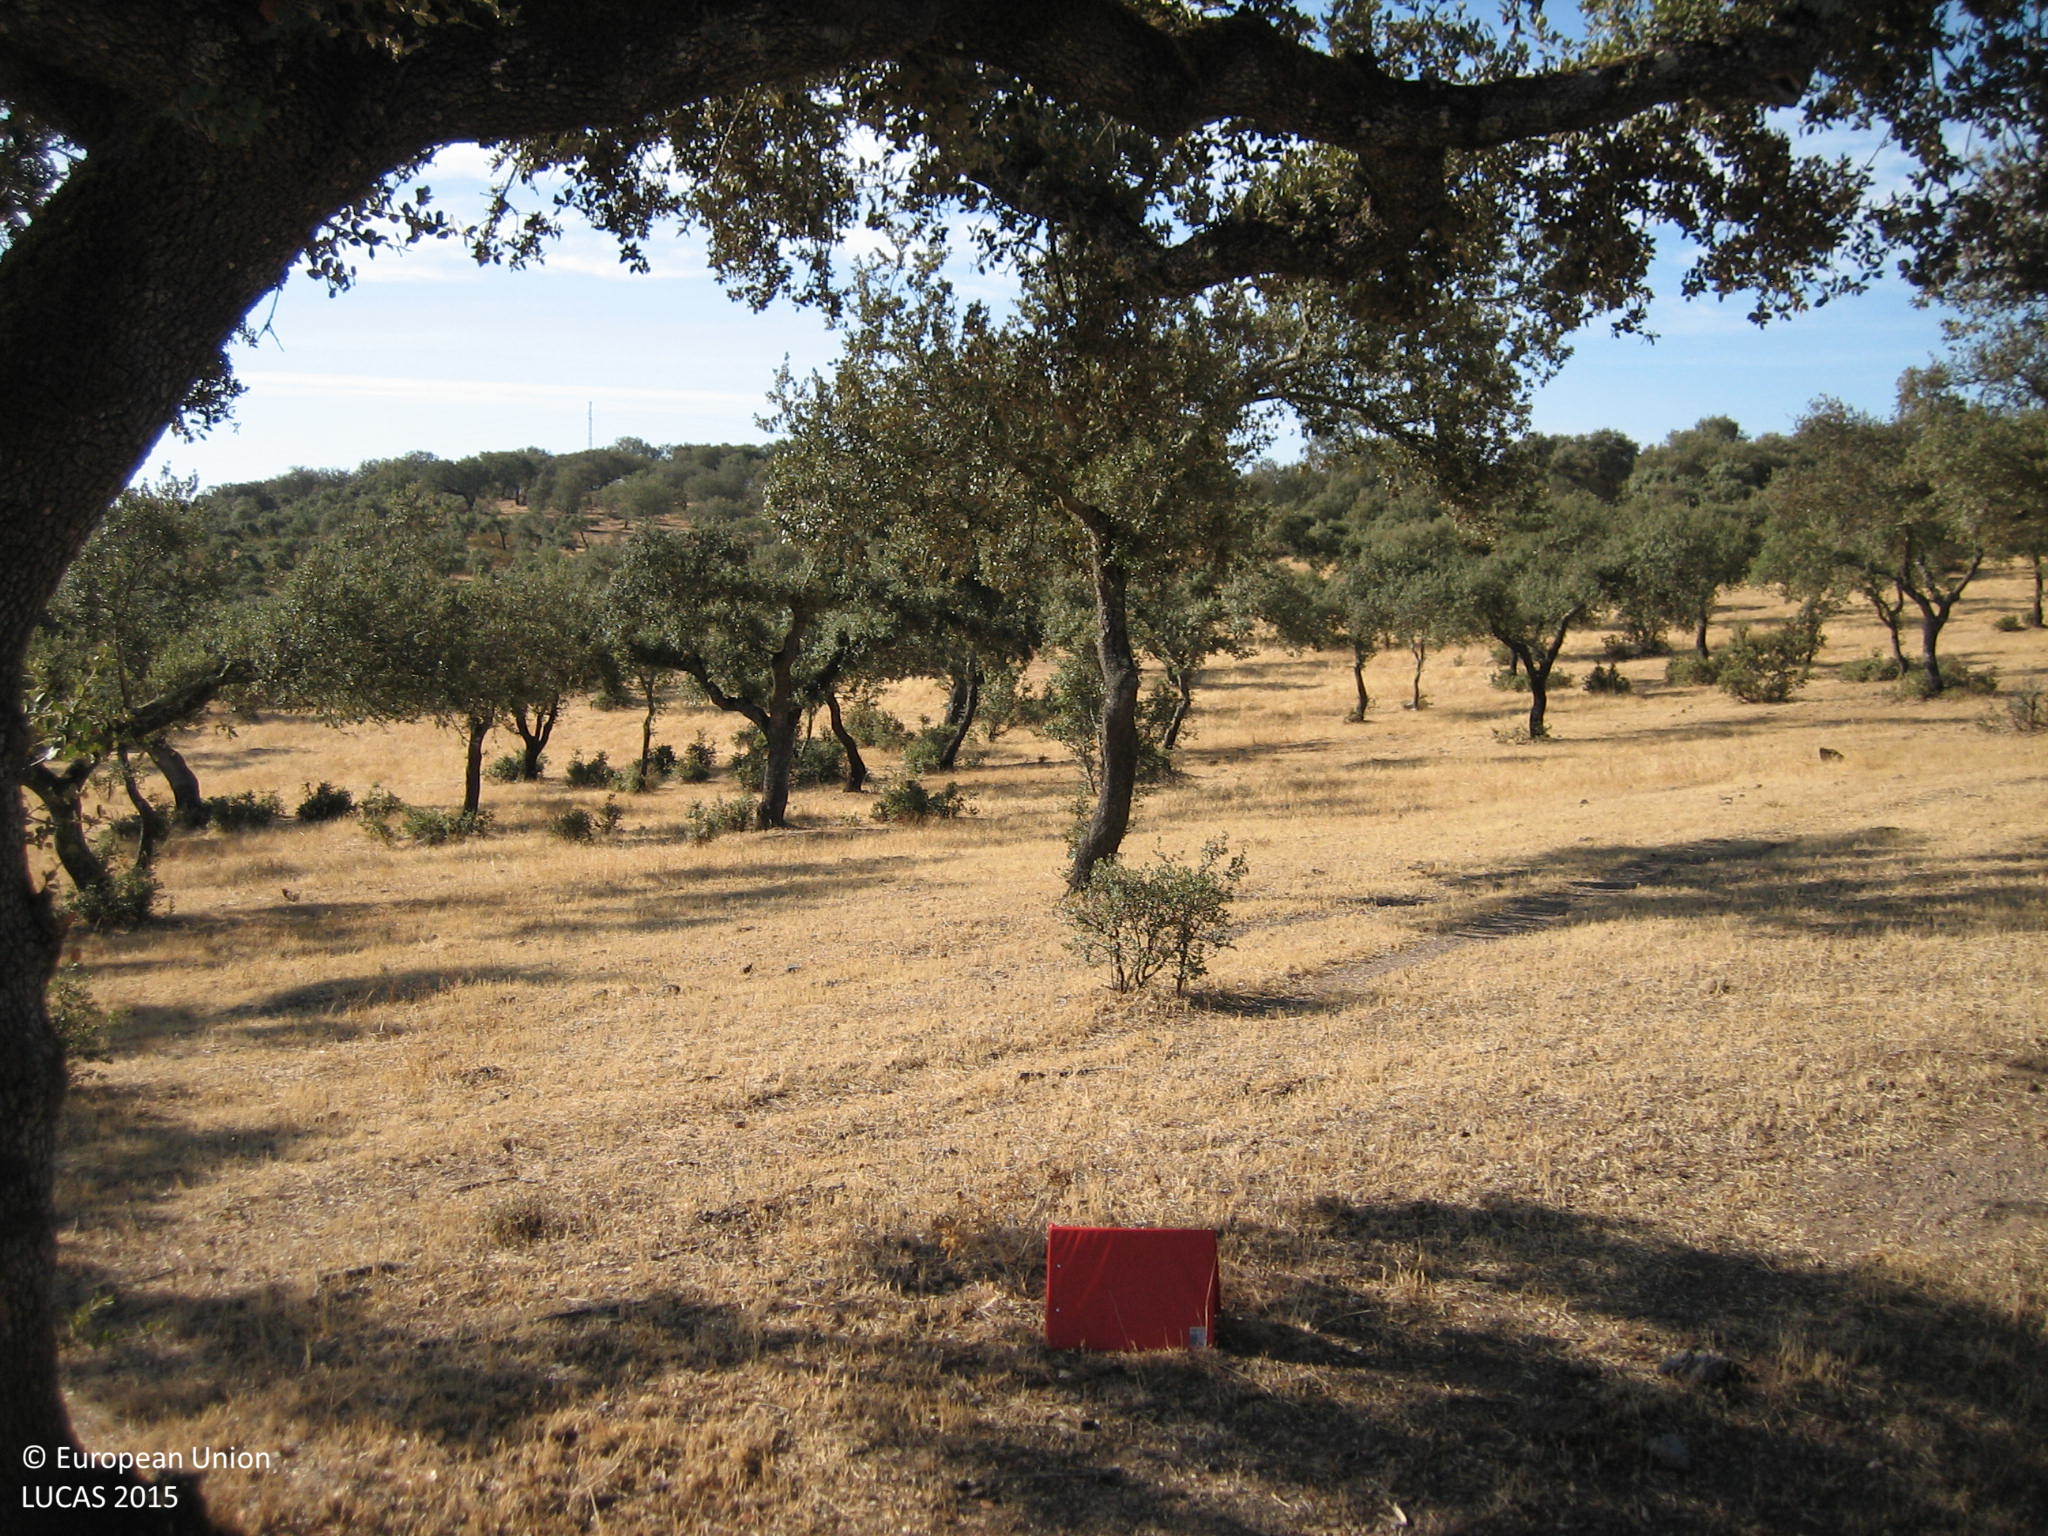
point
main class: Woodland
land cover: Broadleaved woodland
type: broadleaved evergreen forest
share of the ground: 10 - 25 %
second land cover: Grassland without tree/shrub cover
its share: > 75 %
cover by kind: herbaceous plants 80 %, broadleaved forest trees 10 %, unconsolidated bare surface 10 %
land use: Forestry
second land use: Agriculture (excluding fallow land and kitchen gardens)
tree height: < 5 m
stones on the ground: < 10 %
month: August
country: ES
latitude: 38.5427
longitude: -7.2449
